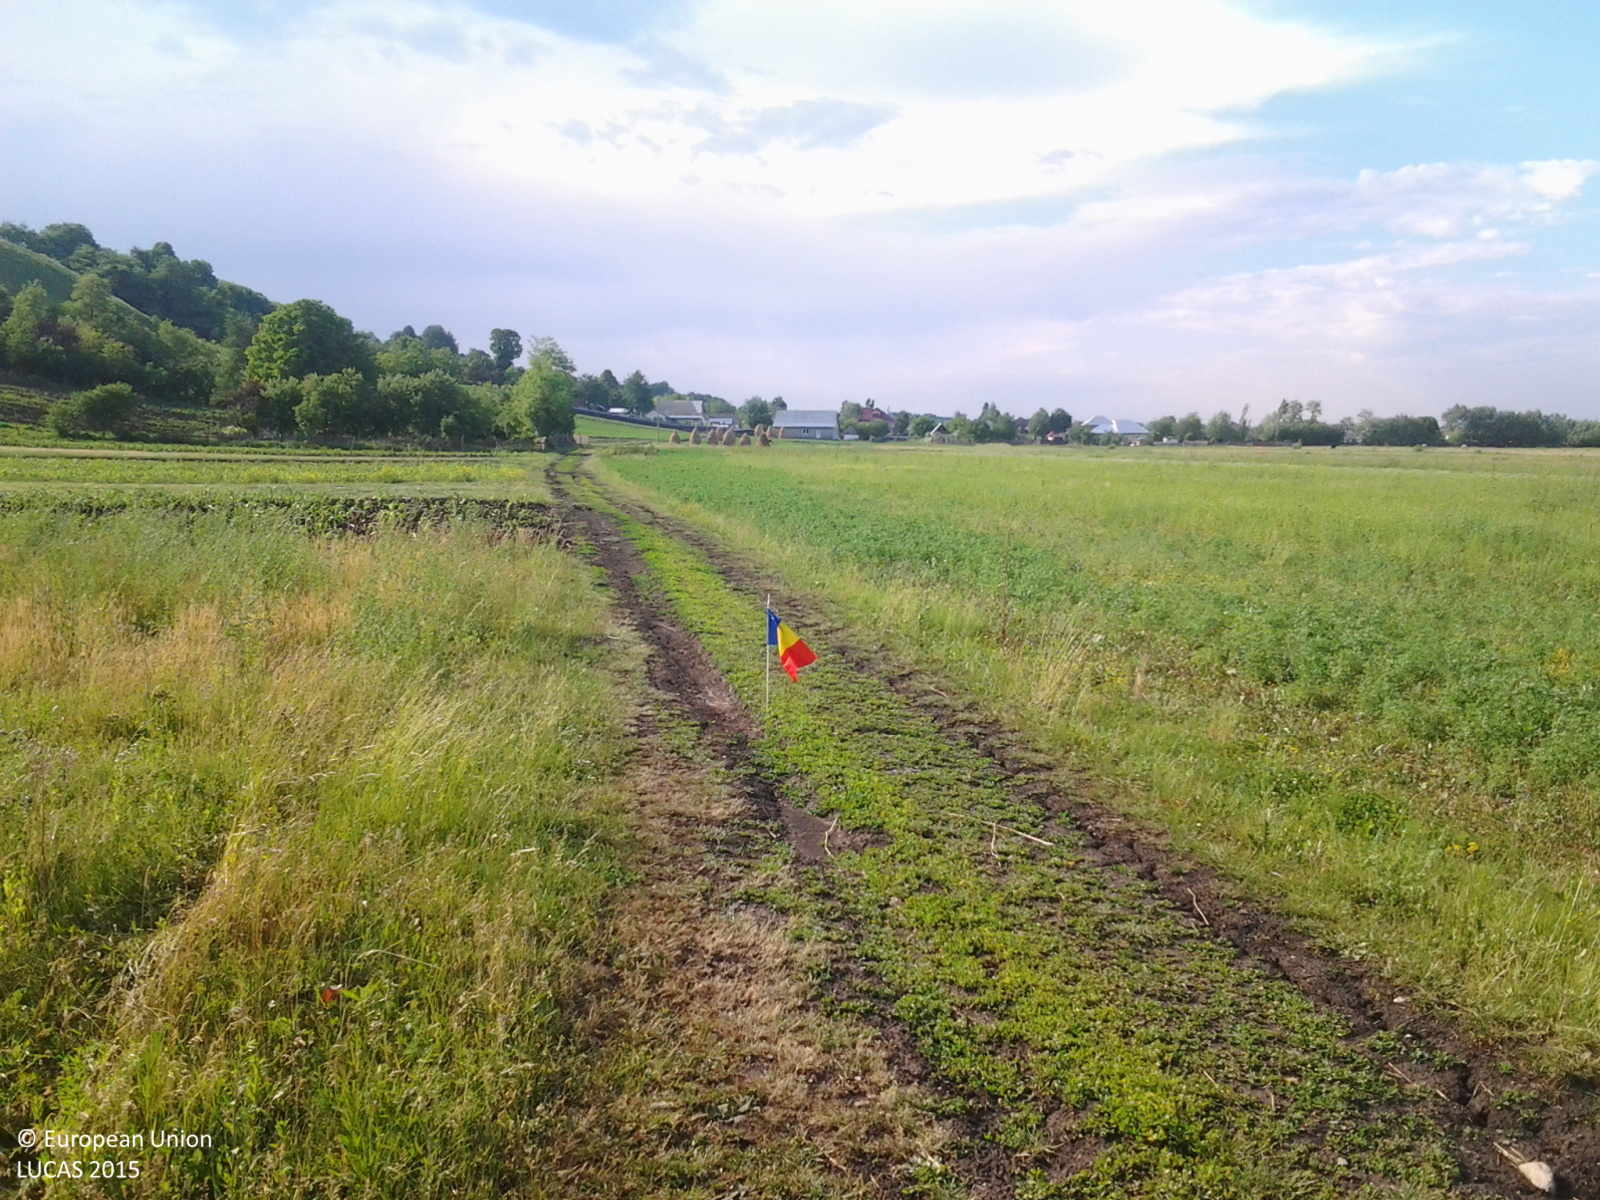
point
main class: Cropland
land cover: Lucerne
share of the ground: > 75 %
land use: Agriculture (excluding fallow land and kitchen gardens)
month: June
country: RO
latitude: 46.7346
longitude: 26.5883
